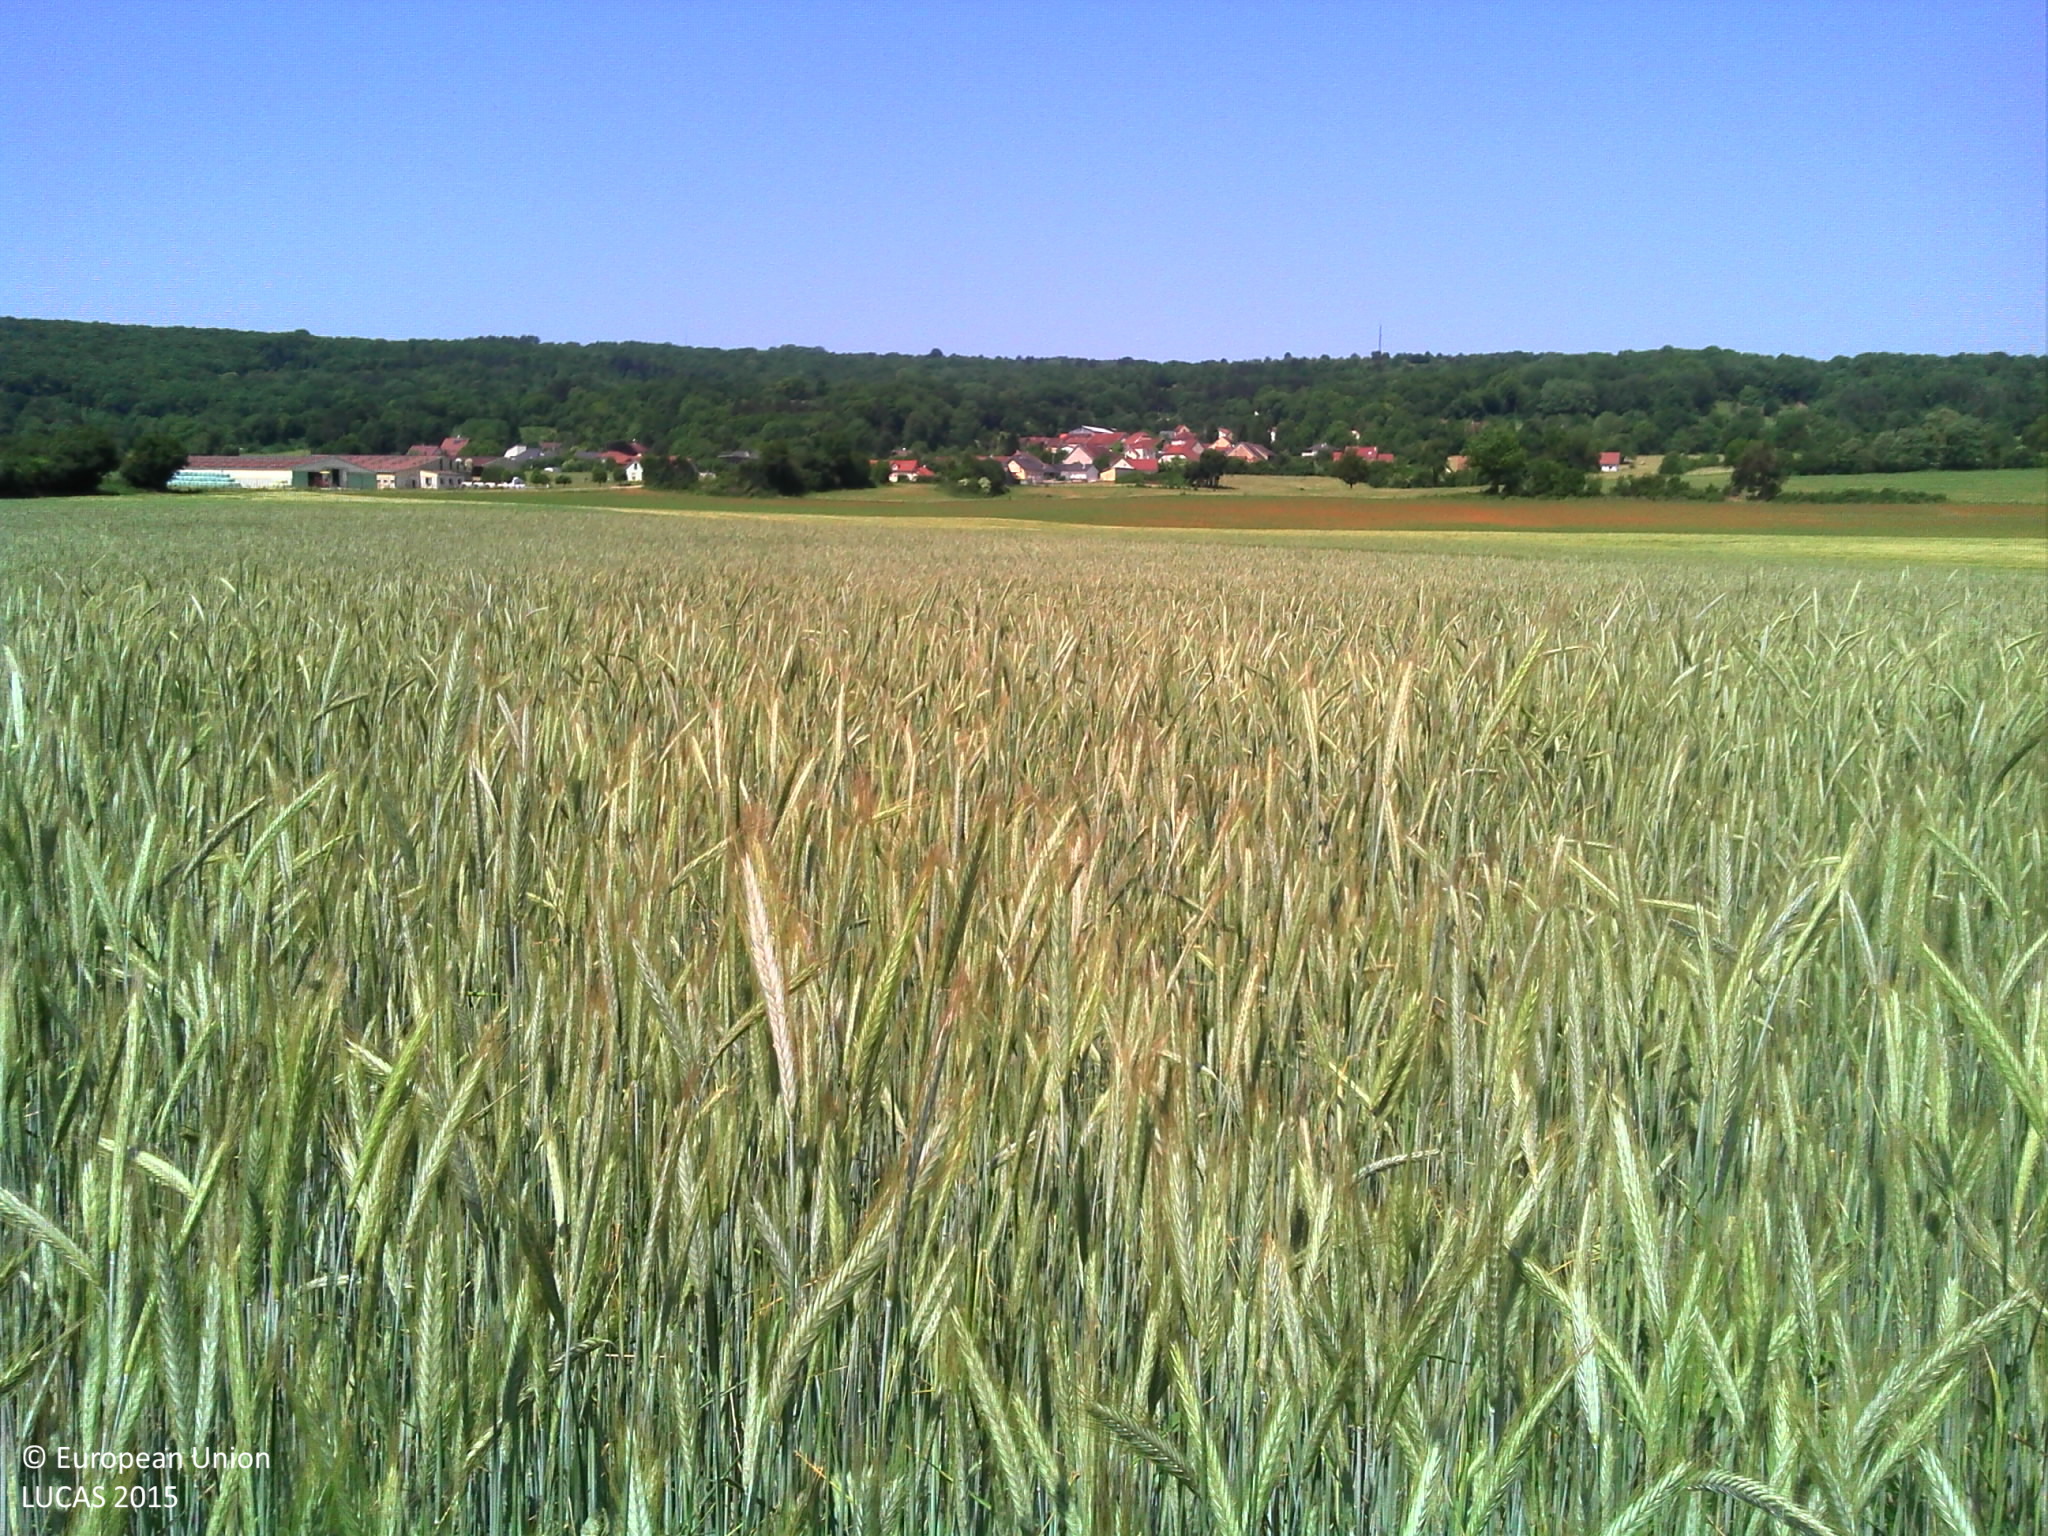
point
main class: Cropland
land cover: Rye
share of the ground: > 75 %
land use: Agriculture (excluding fallow land and kitchen gardens)
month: June
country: FR
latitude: 47.5810
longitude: 6.1855
